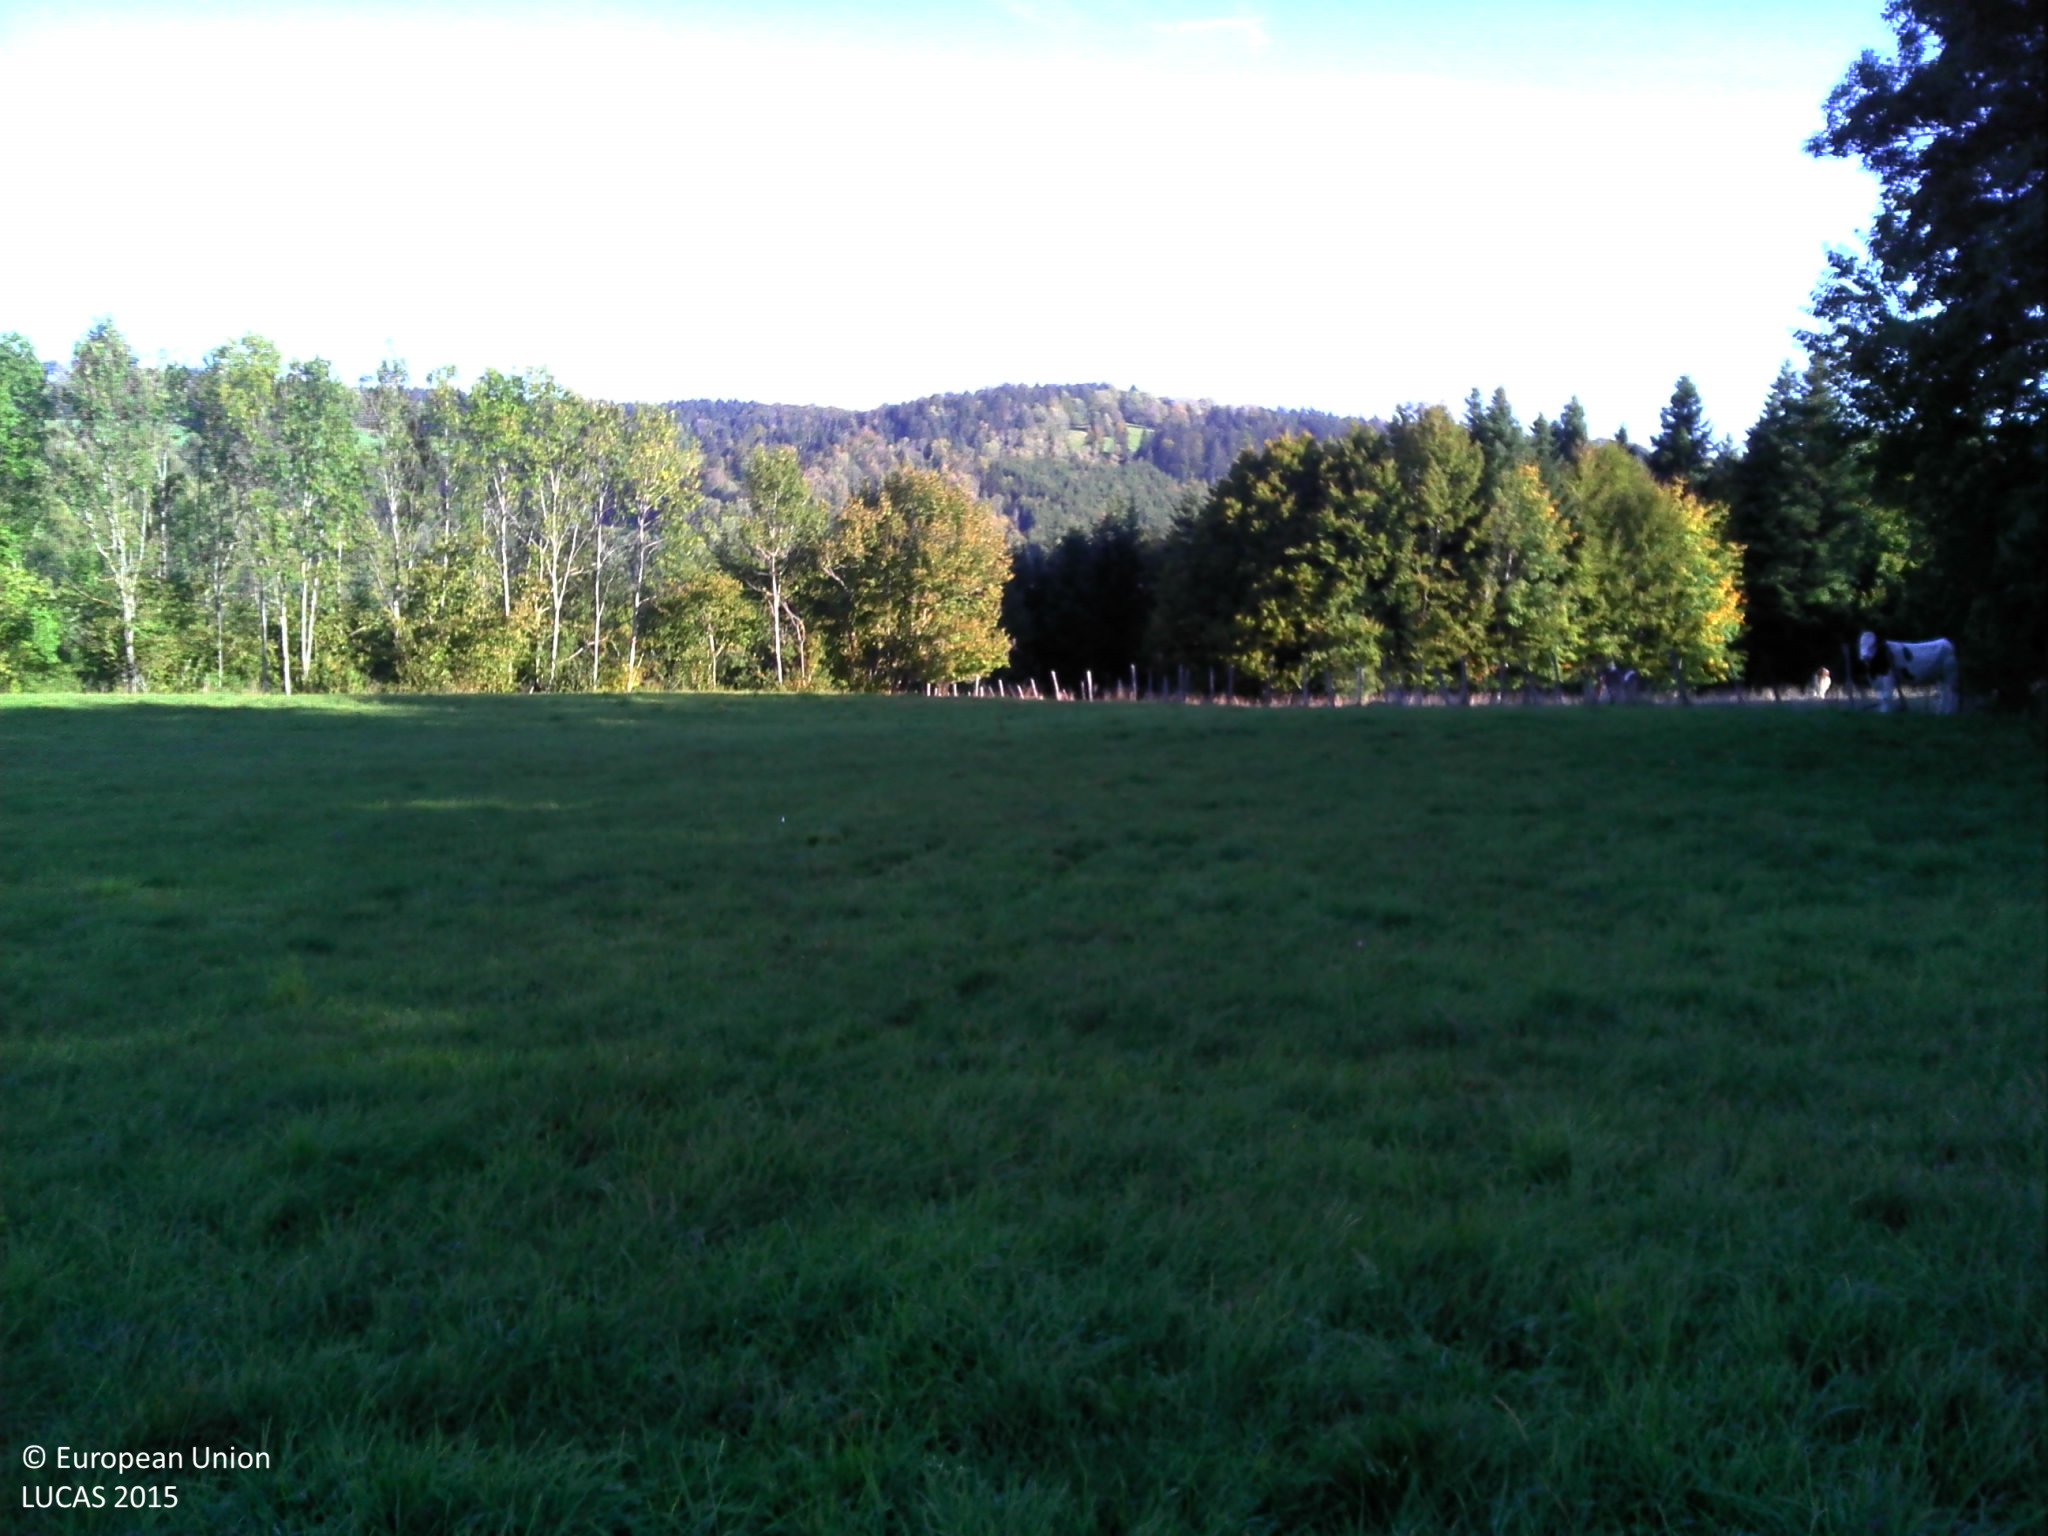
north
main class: Grassland
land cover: Grassland without tree/shrub cover
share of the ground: > 75 %
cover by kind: herbaceous plants 100 %
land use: Agriculture (excluding fallow land and kitchen gardens)
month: September
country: FR
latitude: 47.2800
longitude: 6.9217
